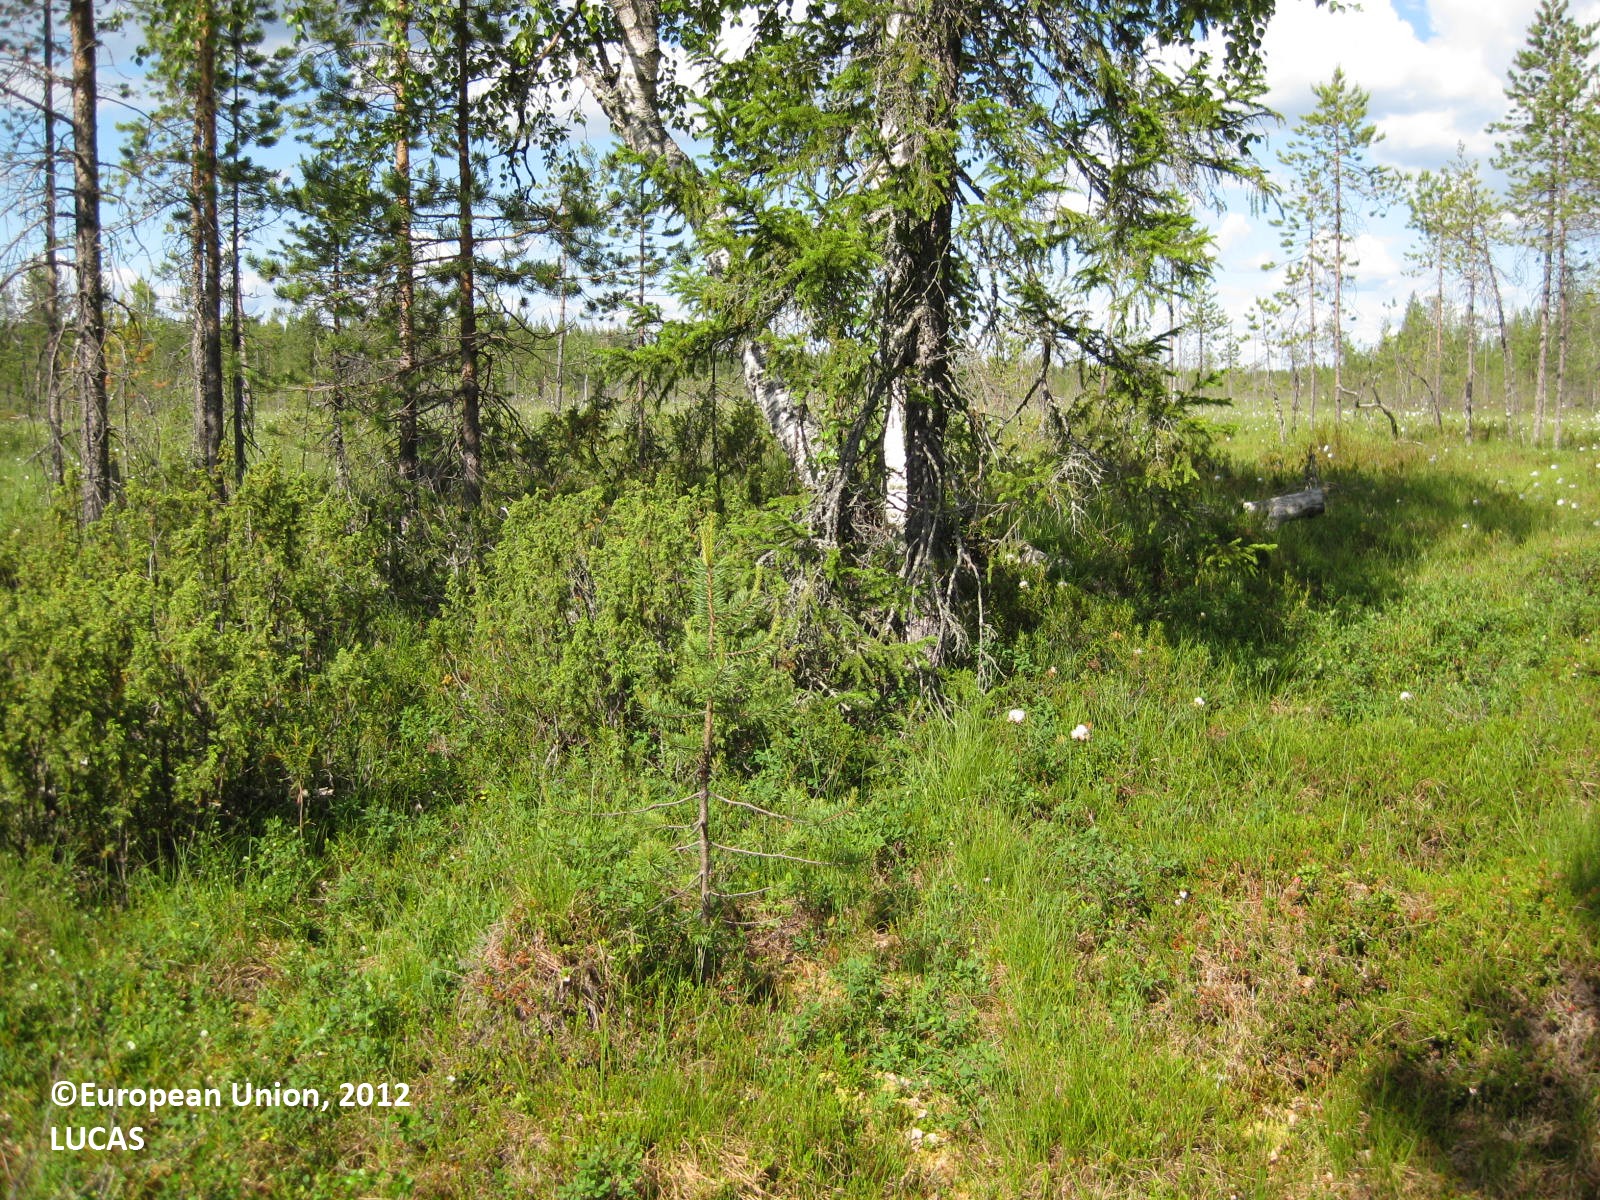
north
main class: Woodland
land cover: Pine dominated coniferous woodland
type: boreal forest
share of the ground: 50 - 75 %
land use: Forestry
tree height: > 5 m
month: July
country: FI
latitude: 65.5223
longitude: 29.4238
